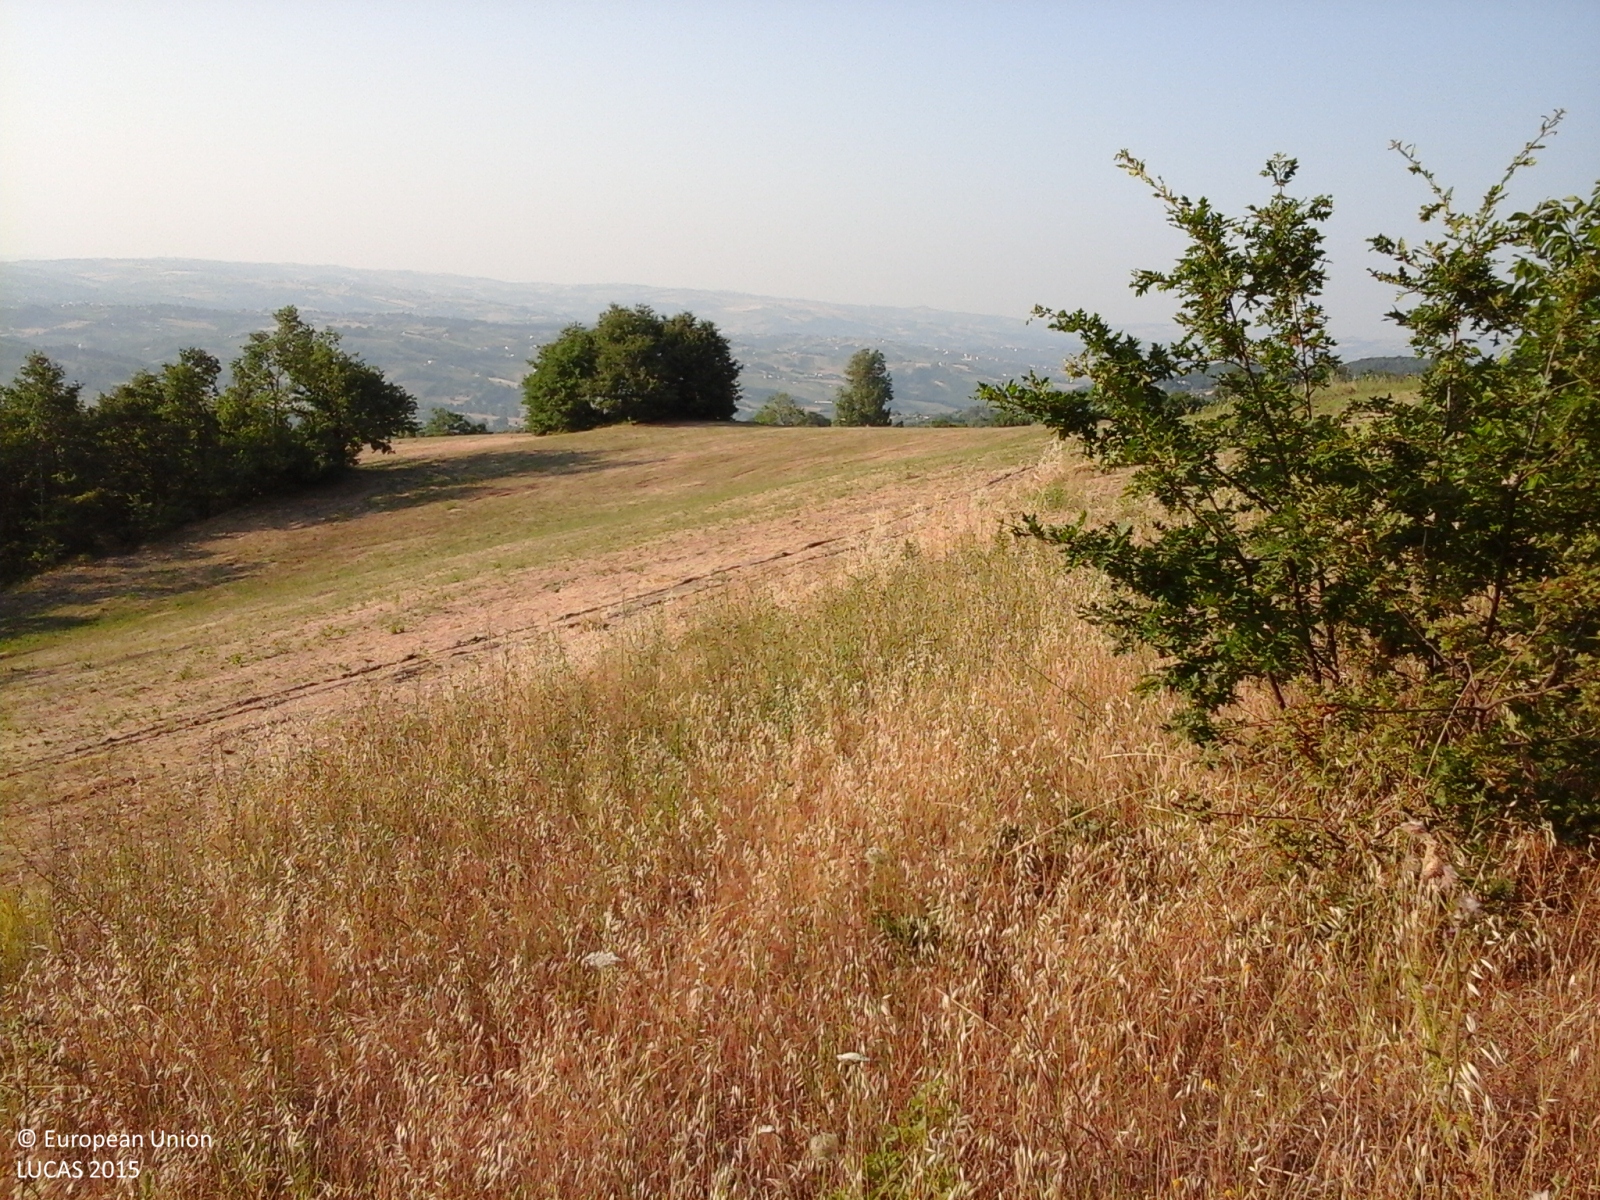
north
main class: Grassland
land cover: Grassland with sparse tree/shrub cover
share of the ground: > 75 %
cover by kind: herbaceous plants 90 %, broadleaved forest trees 5 %, shrubs 5 %
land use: Agriculture (excluding fallow land and kitchen gardens)
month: July
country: IT
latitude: 41.4946
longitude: 14.7149
